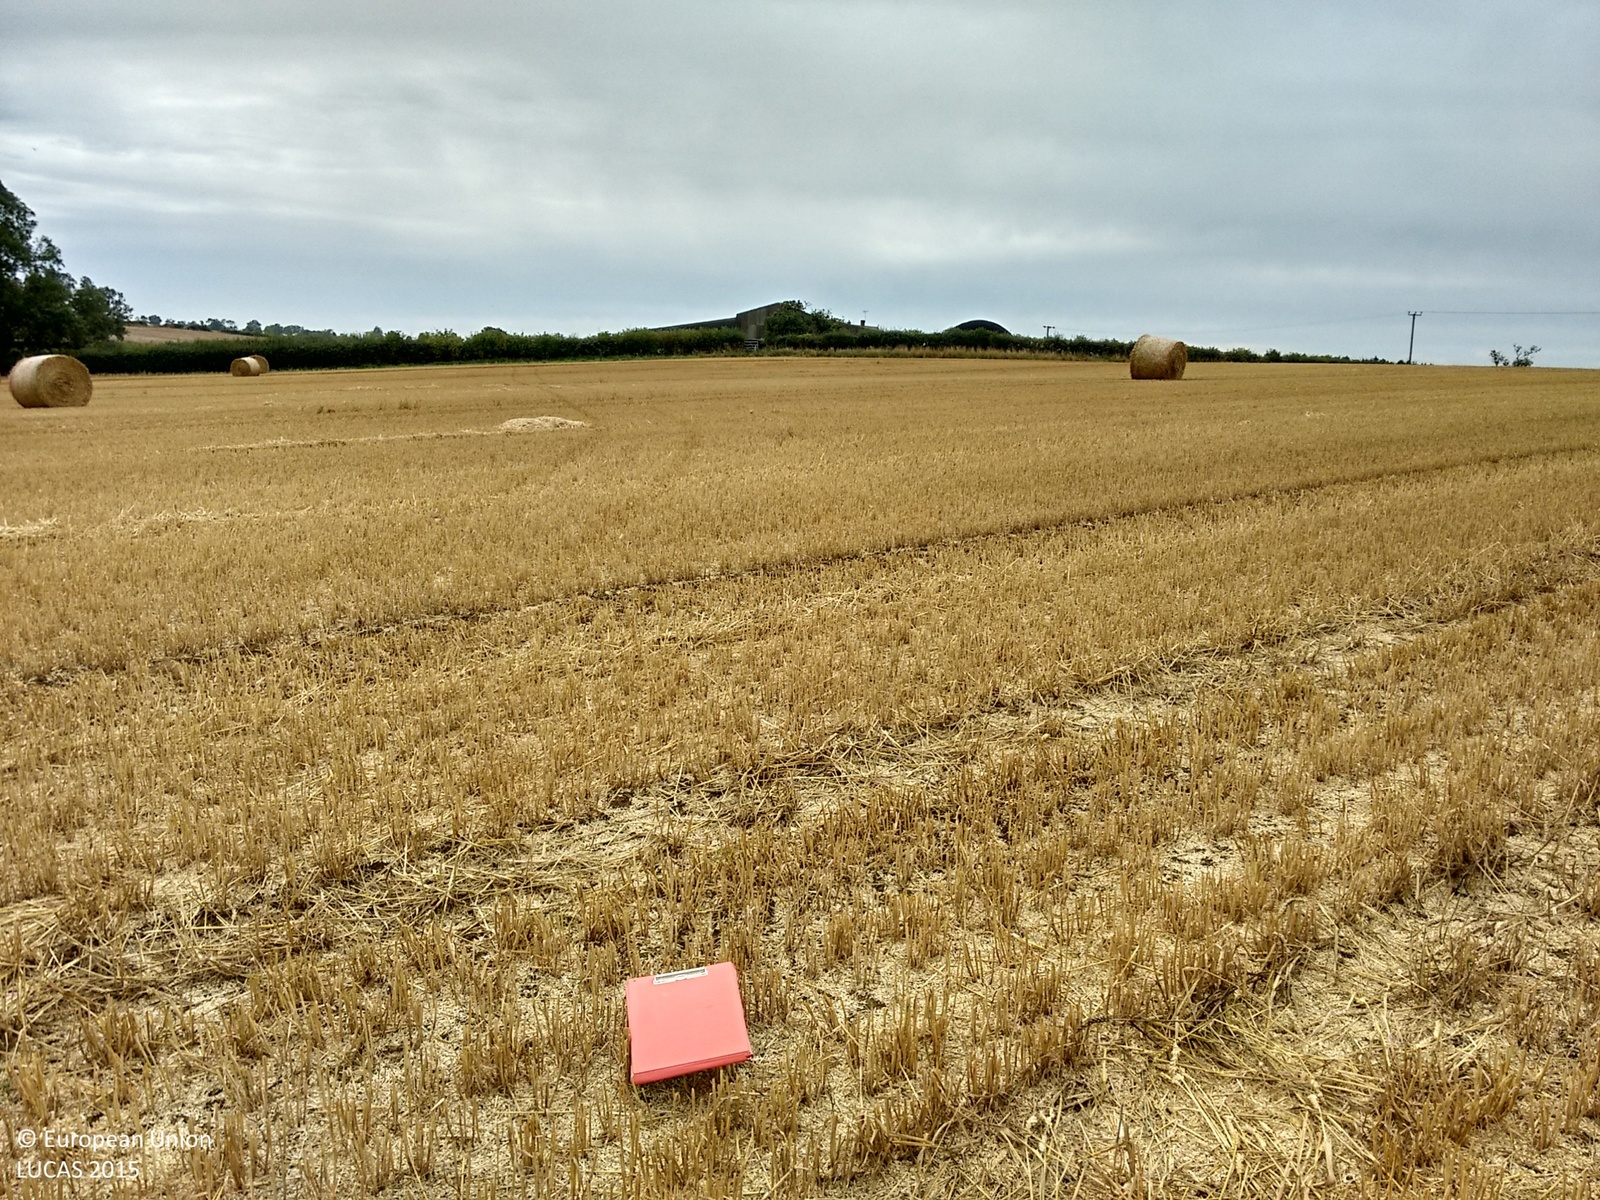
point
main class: Cropland
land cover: Common wheat
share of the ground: 10 - 25 %
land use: Agriculture (excluding fallow land and kitchen gardens)
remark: Harvested field
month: August
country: GB
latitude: 52.4202
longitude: -0.8797
